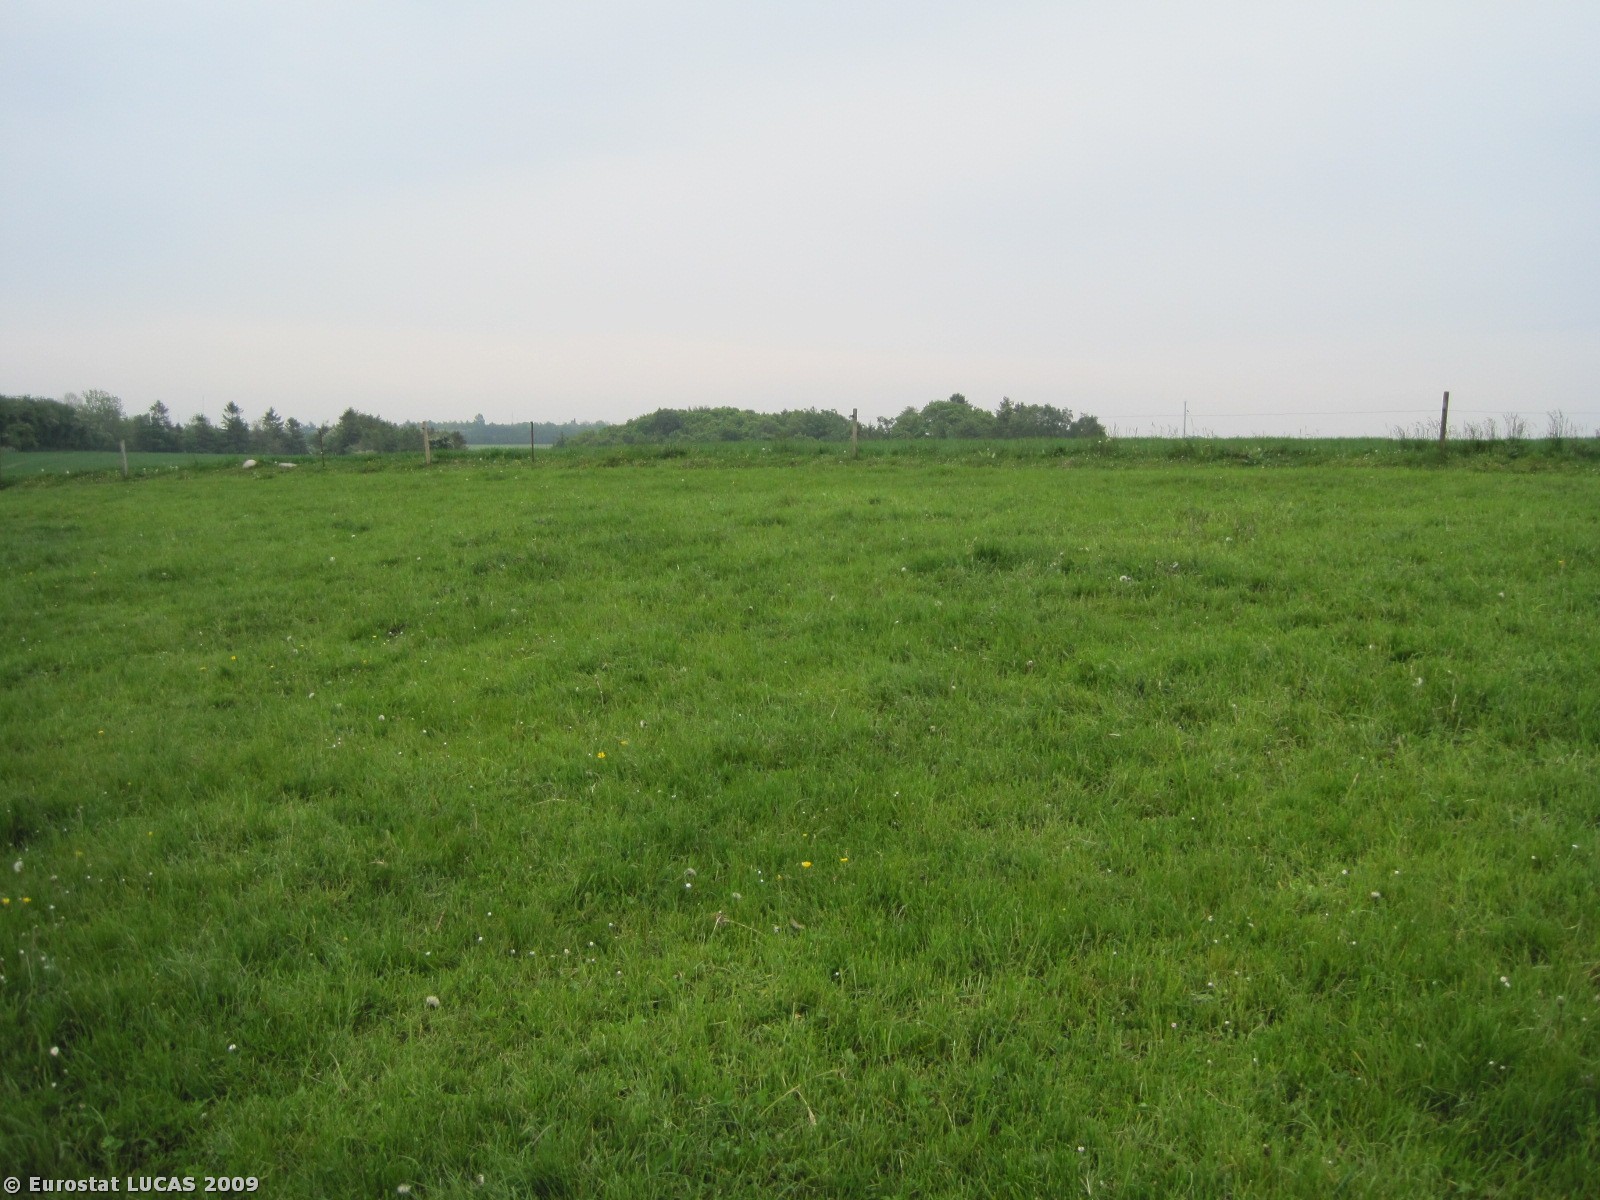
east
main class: Grassland
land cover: Grassland without tree/shrub cover
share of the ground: > 75 %
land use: Agriculture (excluding fallow land and kitchen gardens)
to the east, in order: Grassland without tree/shrub cover; Fences; Grass margins; Barley
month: May
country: DK
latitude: 56.3136
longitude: 10.0161
